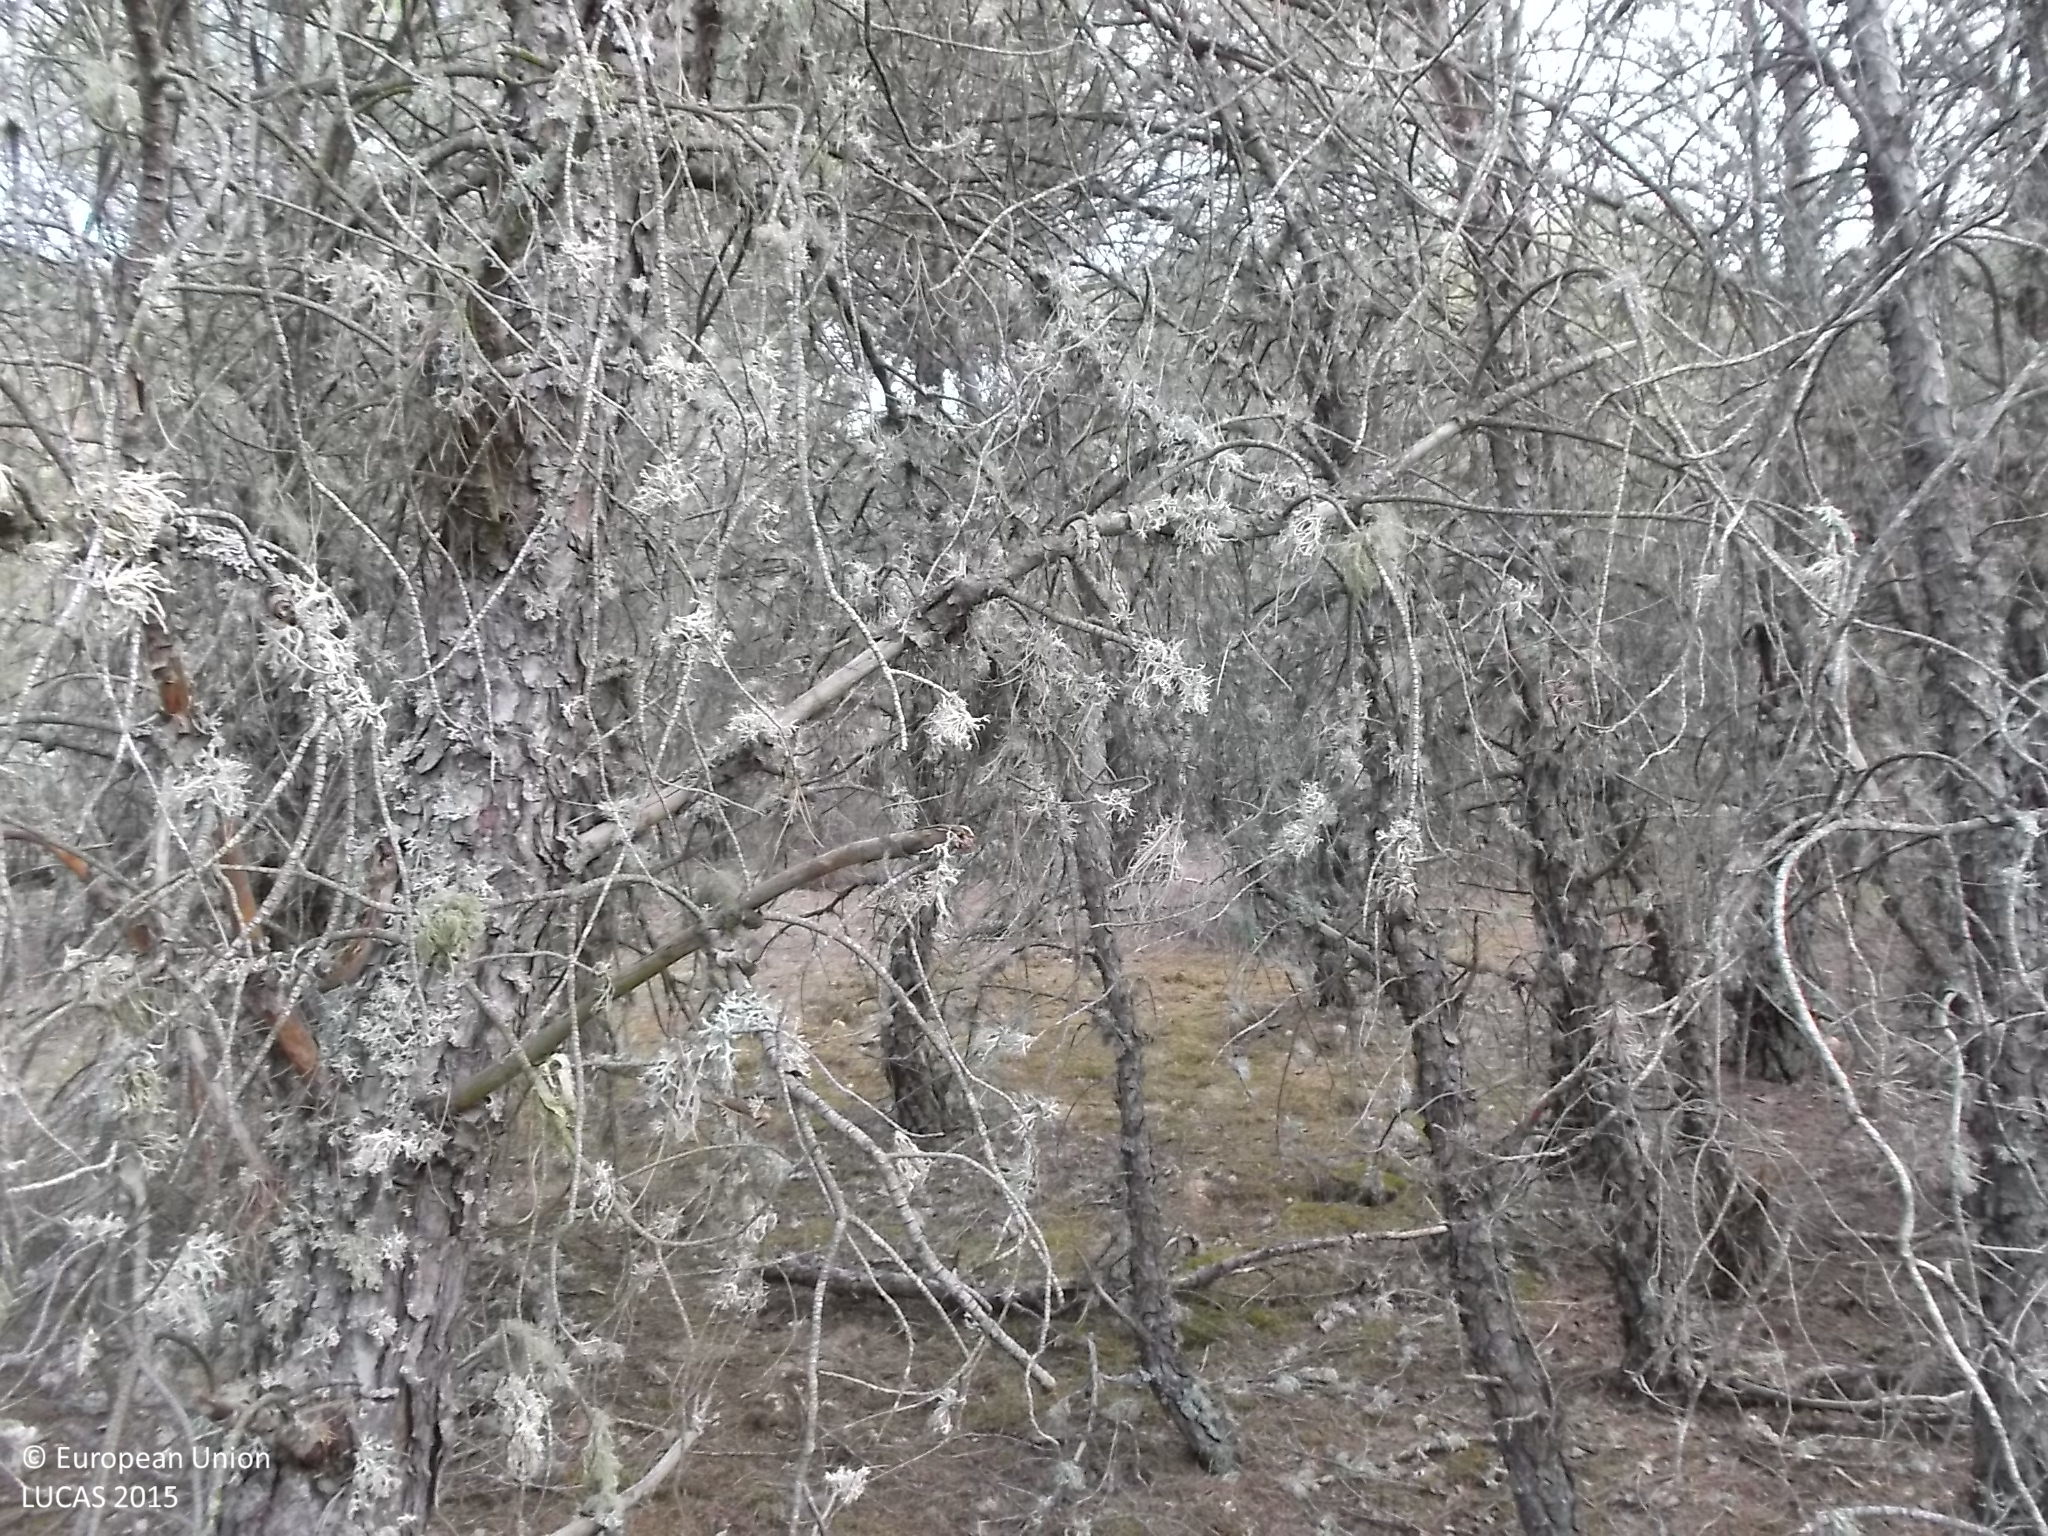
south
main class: Woodland
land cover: Pine dominated coniferous woodland
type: coniferous forest of the mediterranean region
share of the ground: > 75 %
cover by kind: coniferous forest trees 80 %, shrubs 20 %
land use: Semi-natural and natural areas not in use
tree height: > 5 m
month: July
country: ES
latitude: 41.5361
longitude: -5.4349
